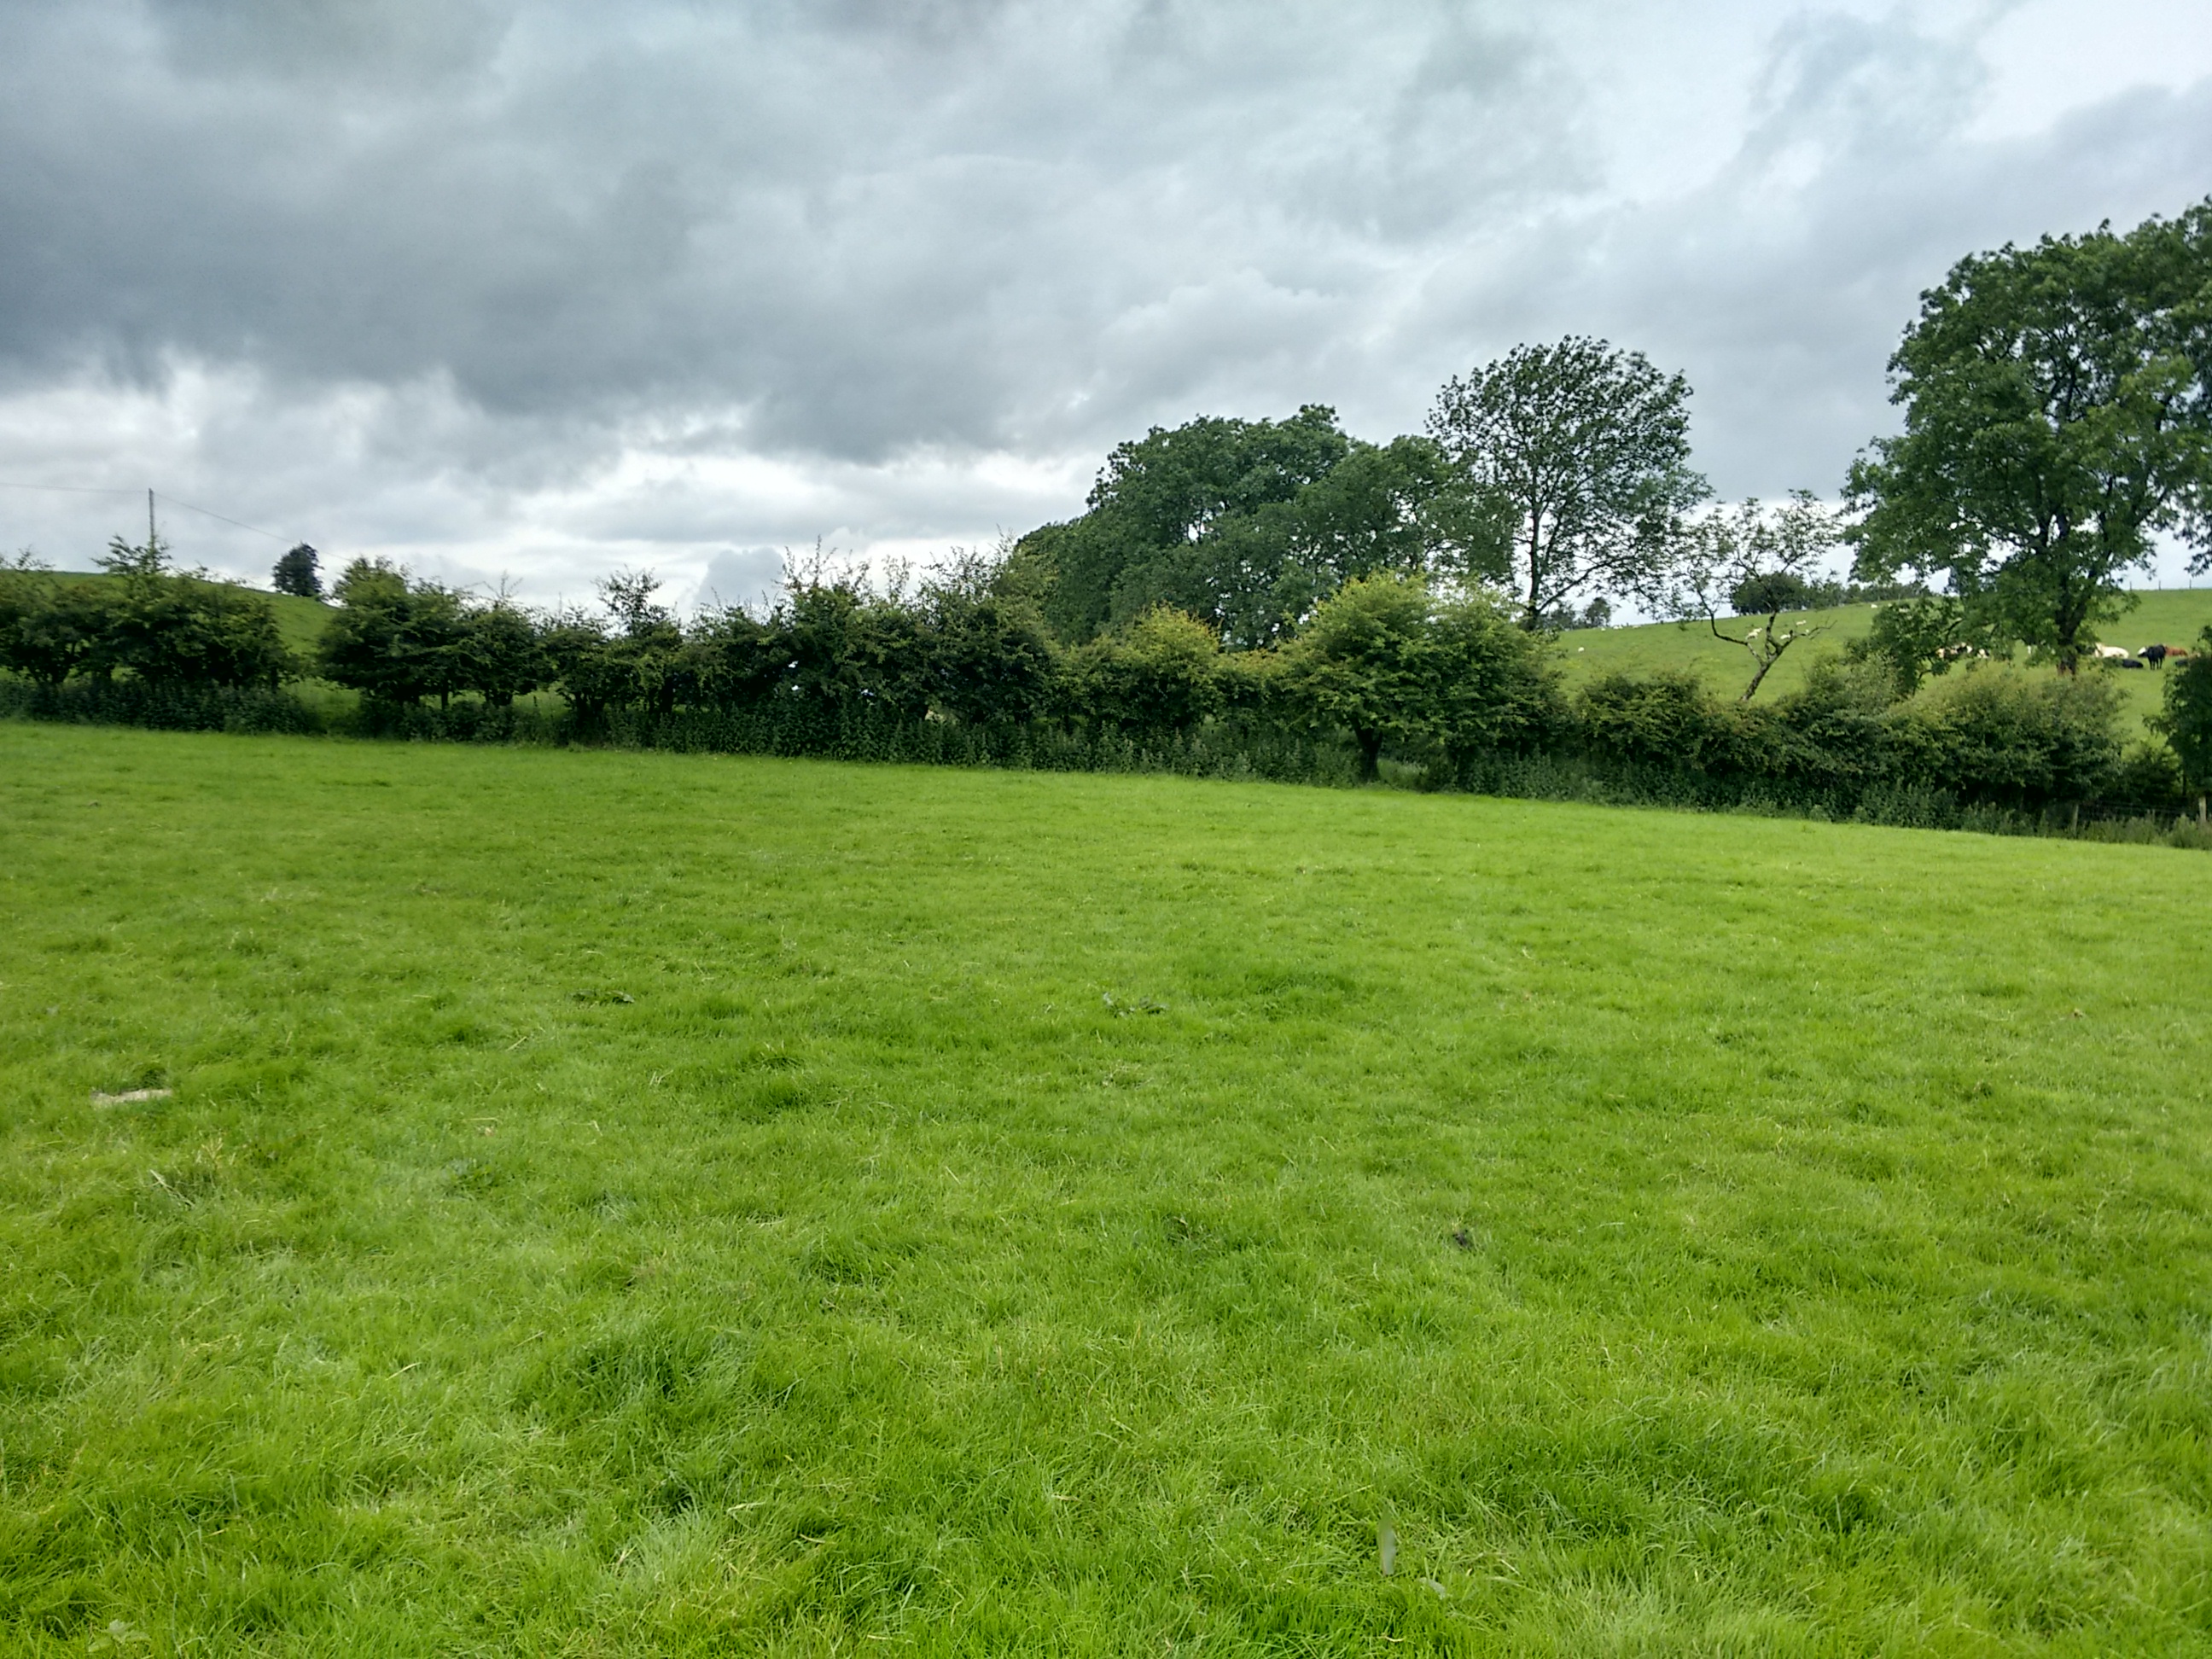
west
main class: Grassland
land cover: Grassland without tree/shrub cover
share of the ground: > 75 %
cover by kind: herbaceous plants 100 %
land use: Agriculture (excluding fallow land and kitchen gardens)
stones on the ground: 10 - 25 %
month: July
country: GB
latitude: 54.5952
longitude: -7.1538
